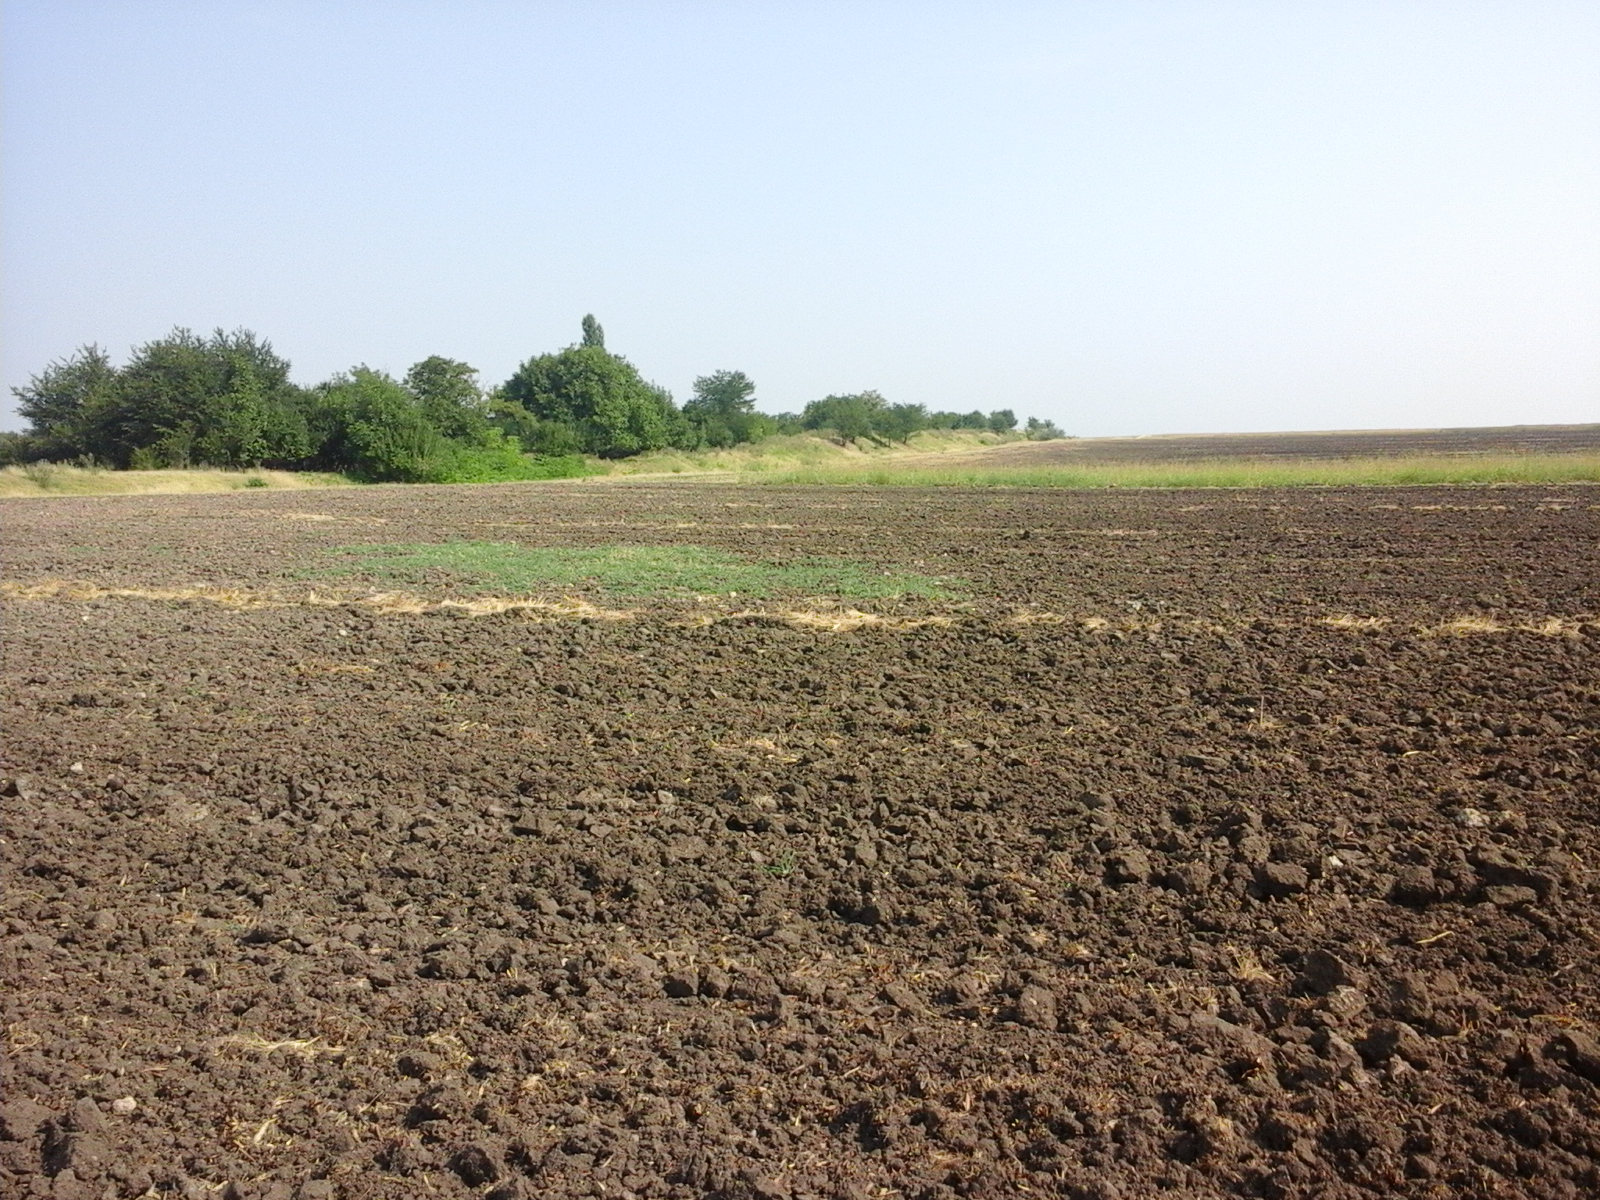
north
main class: Cropland
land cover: Common wheat
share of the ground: < 10 %
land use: Agriculture (excluding fallow land and kitchen gardens)
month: August
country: RO
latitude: 44.0494
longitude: 23.4917
